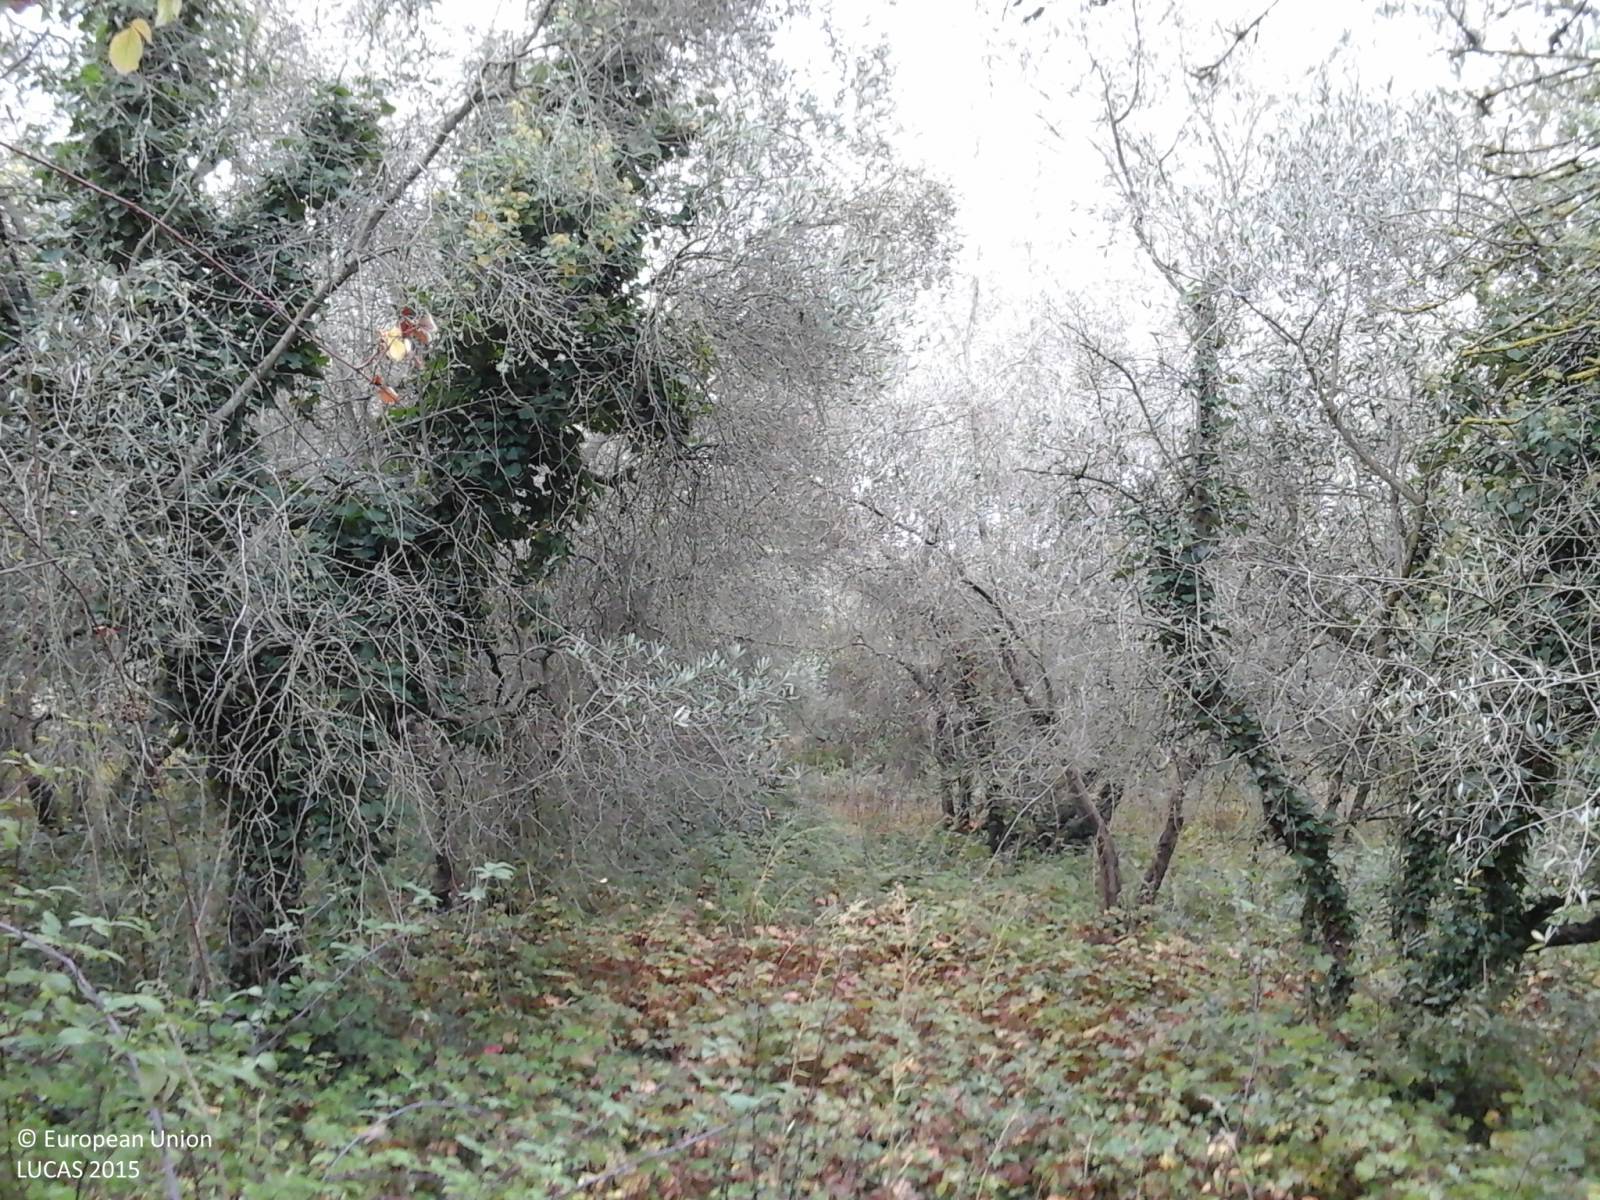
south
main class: Cropland
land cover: Olive groves
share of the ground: 50 - 75 %
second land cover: Shrubland without tree cover
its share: > 75 %
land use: Abandoned areas
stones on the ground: 10 - 25 %
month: October
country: IT
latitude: 43.0652
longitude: 10.9181
